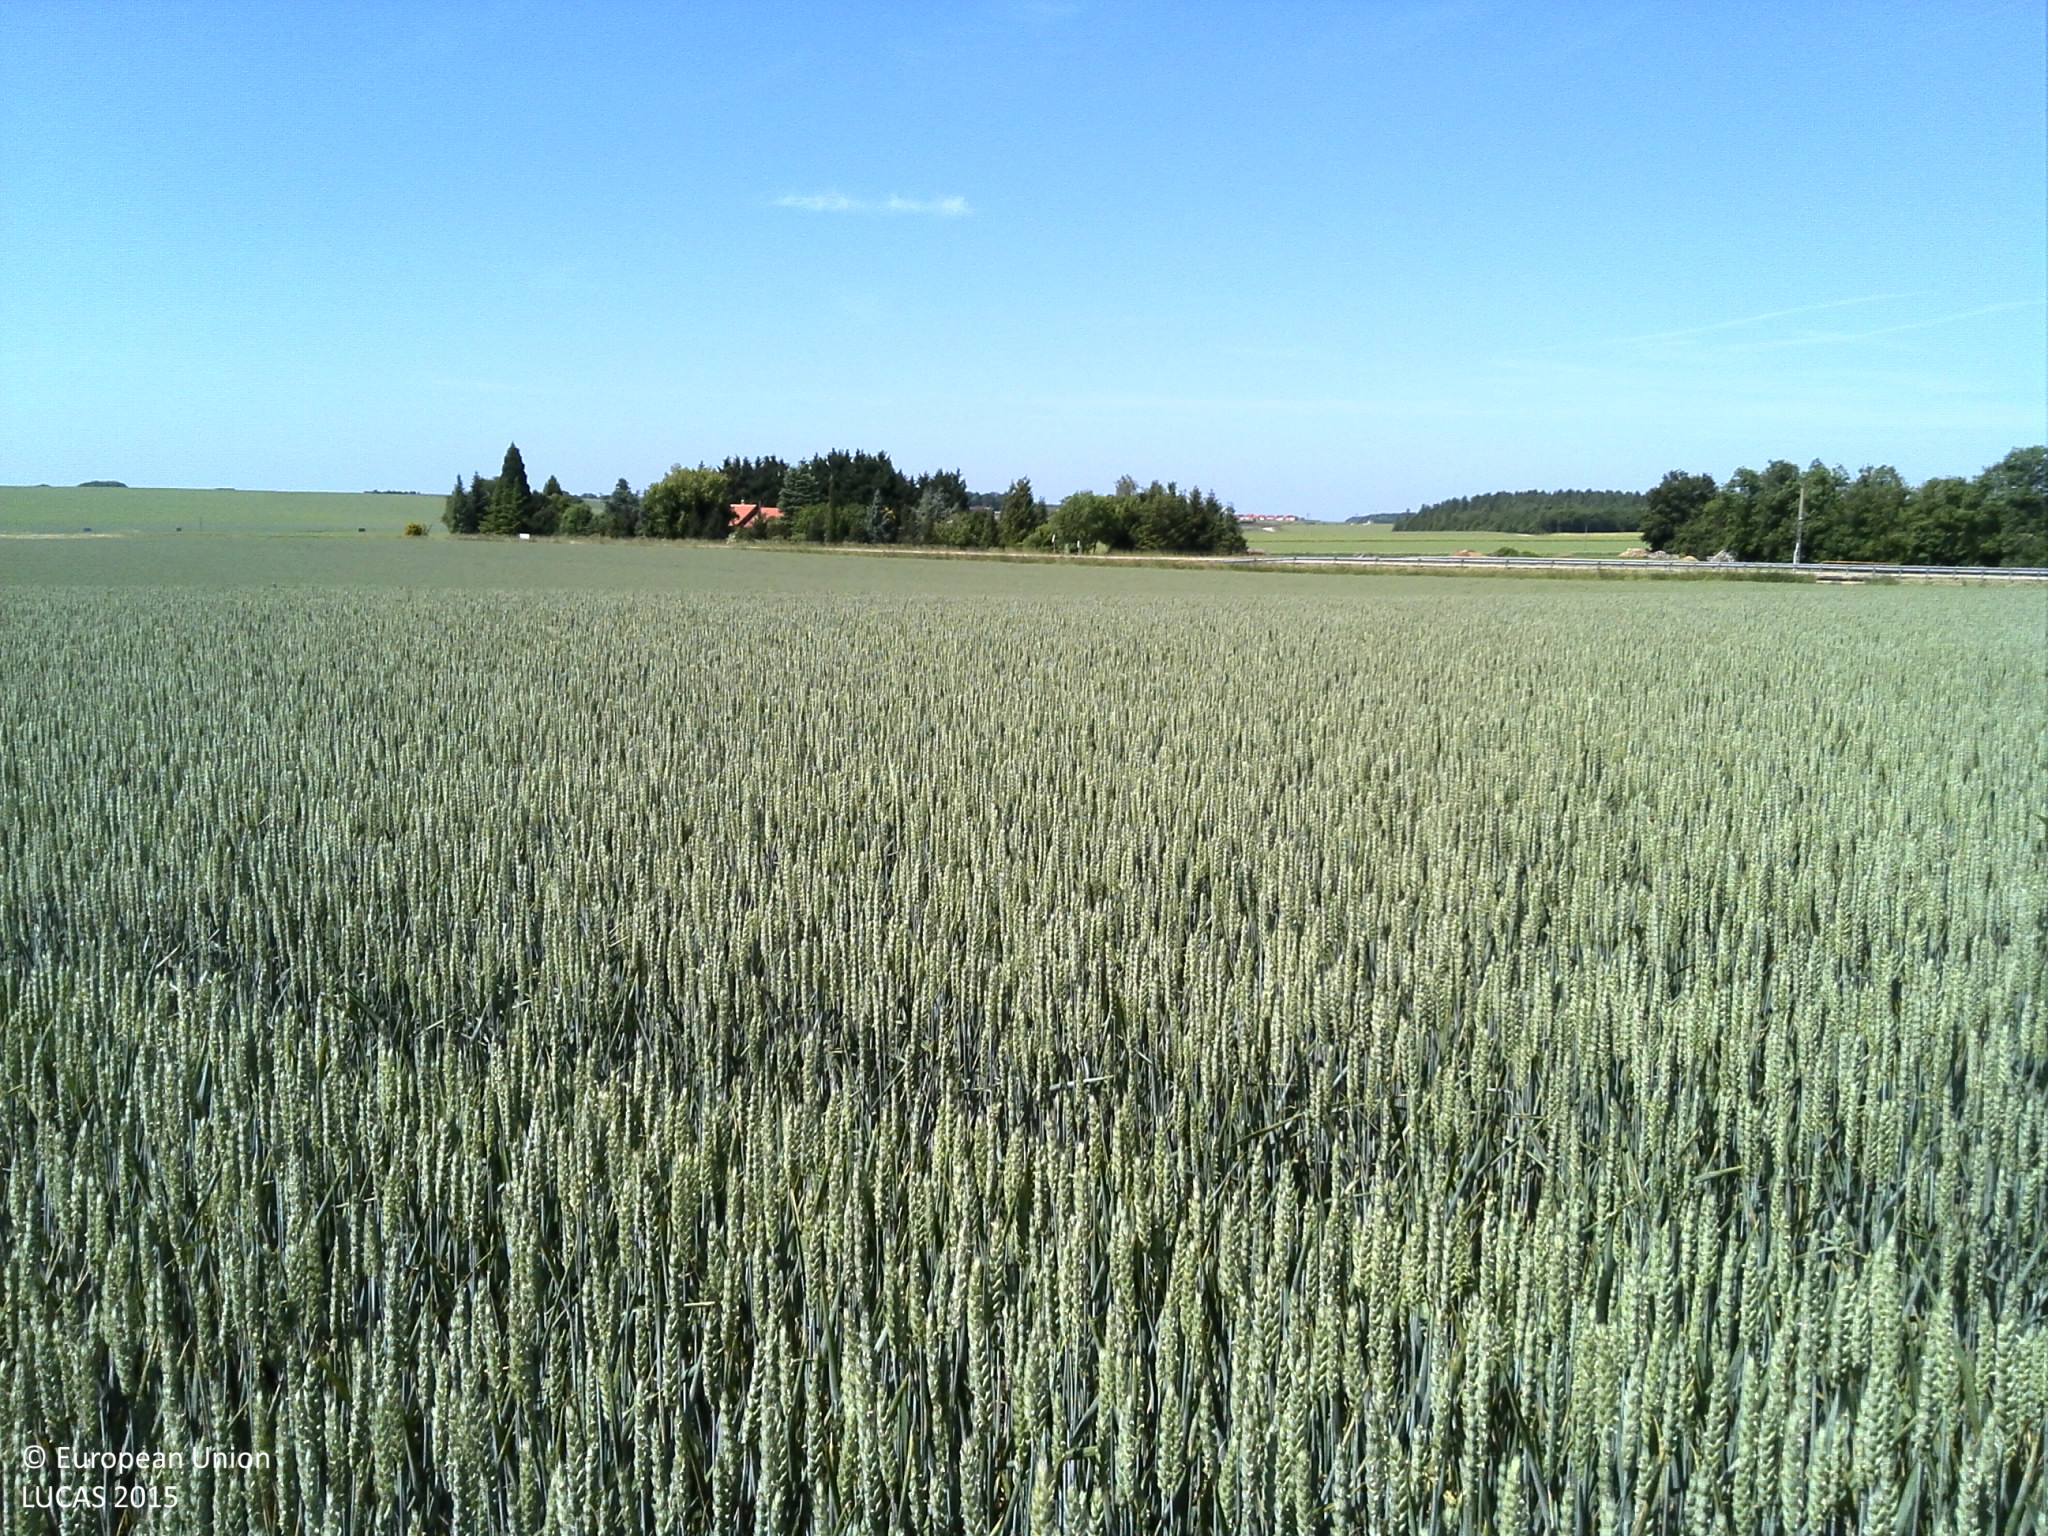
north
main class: Cropland
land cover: Common wheat
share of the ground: > 75 %
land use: Agriculture (excluding fallow land and kitchen gardens)
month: June
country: FR
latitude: 49.1241
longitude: 6.0119
